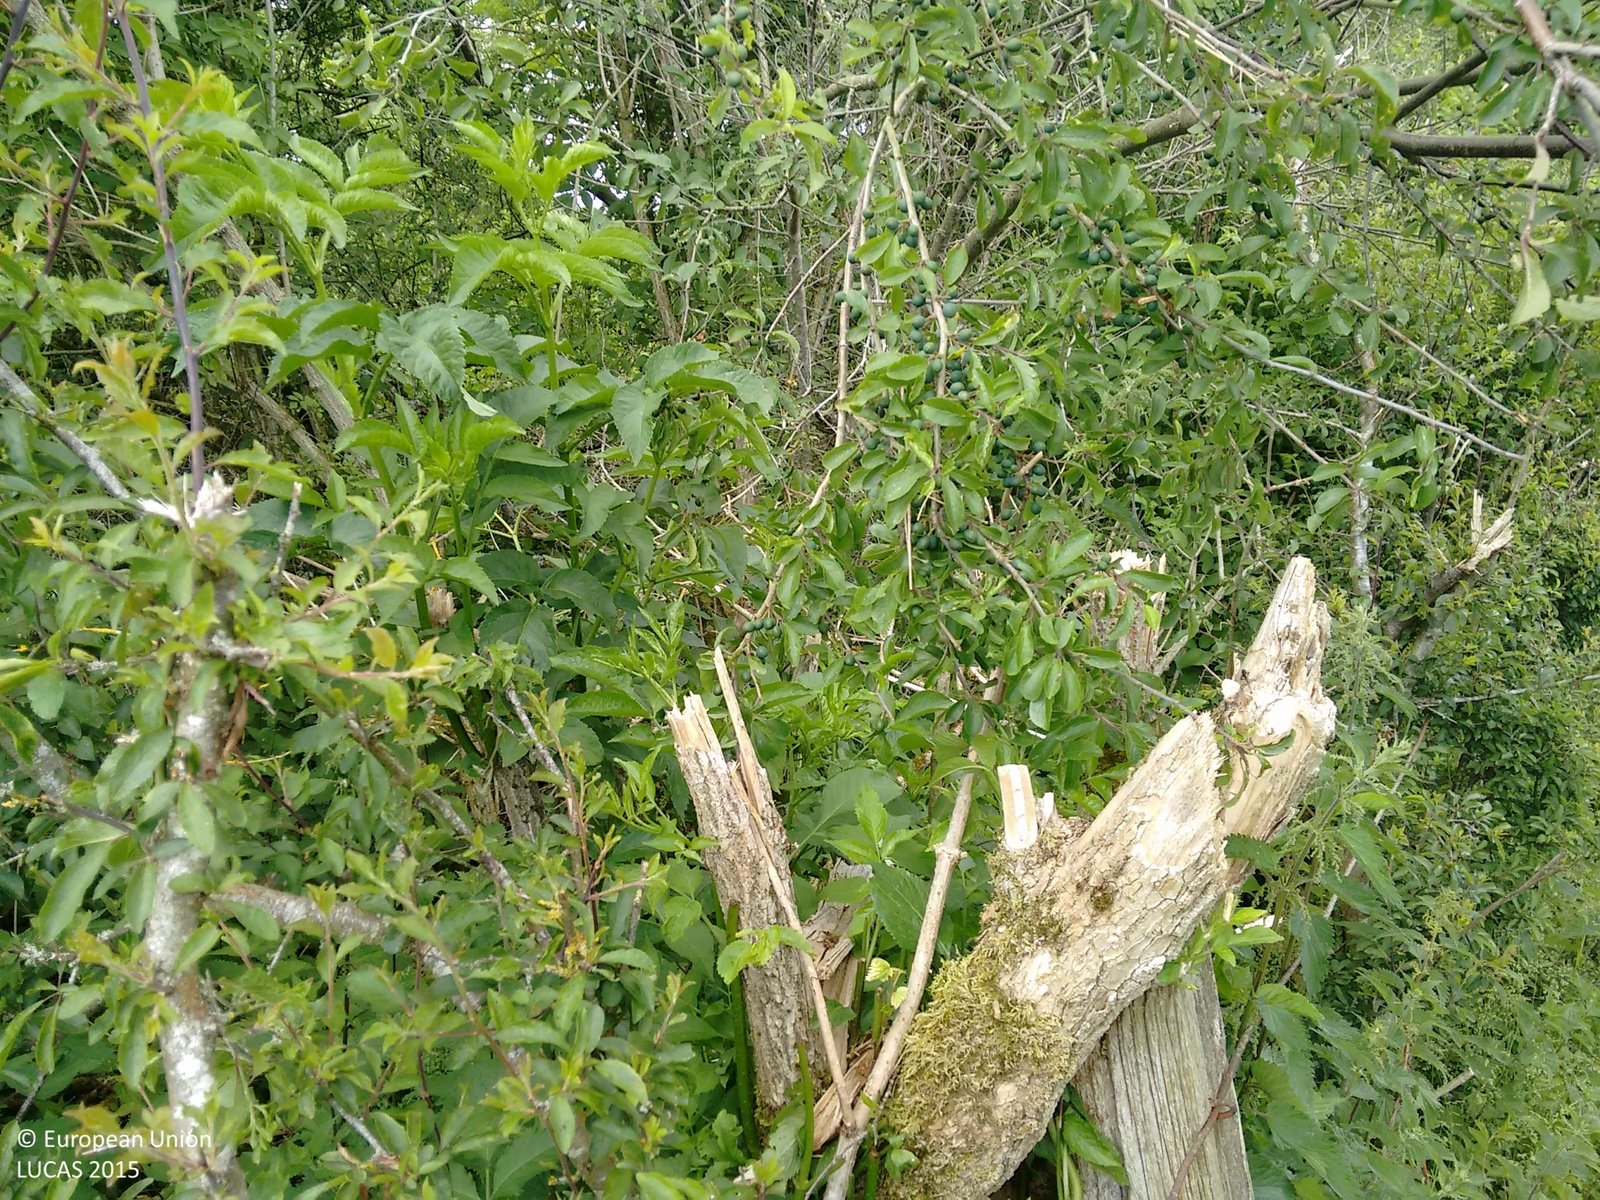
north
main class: Woodland
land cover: Broadleaved woodland
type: mesophytic deciduous forest
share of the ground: > 75 %
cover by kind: broadleaved forest trees 100 %
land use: Agriculture (excluding fallow land and kitchen gardens)
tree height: > 5 m
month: June
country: GB
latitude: 51.3485
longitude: -2.3397
